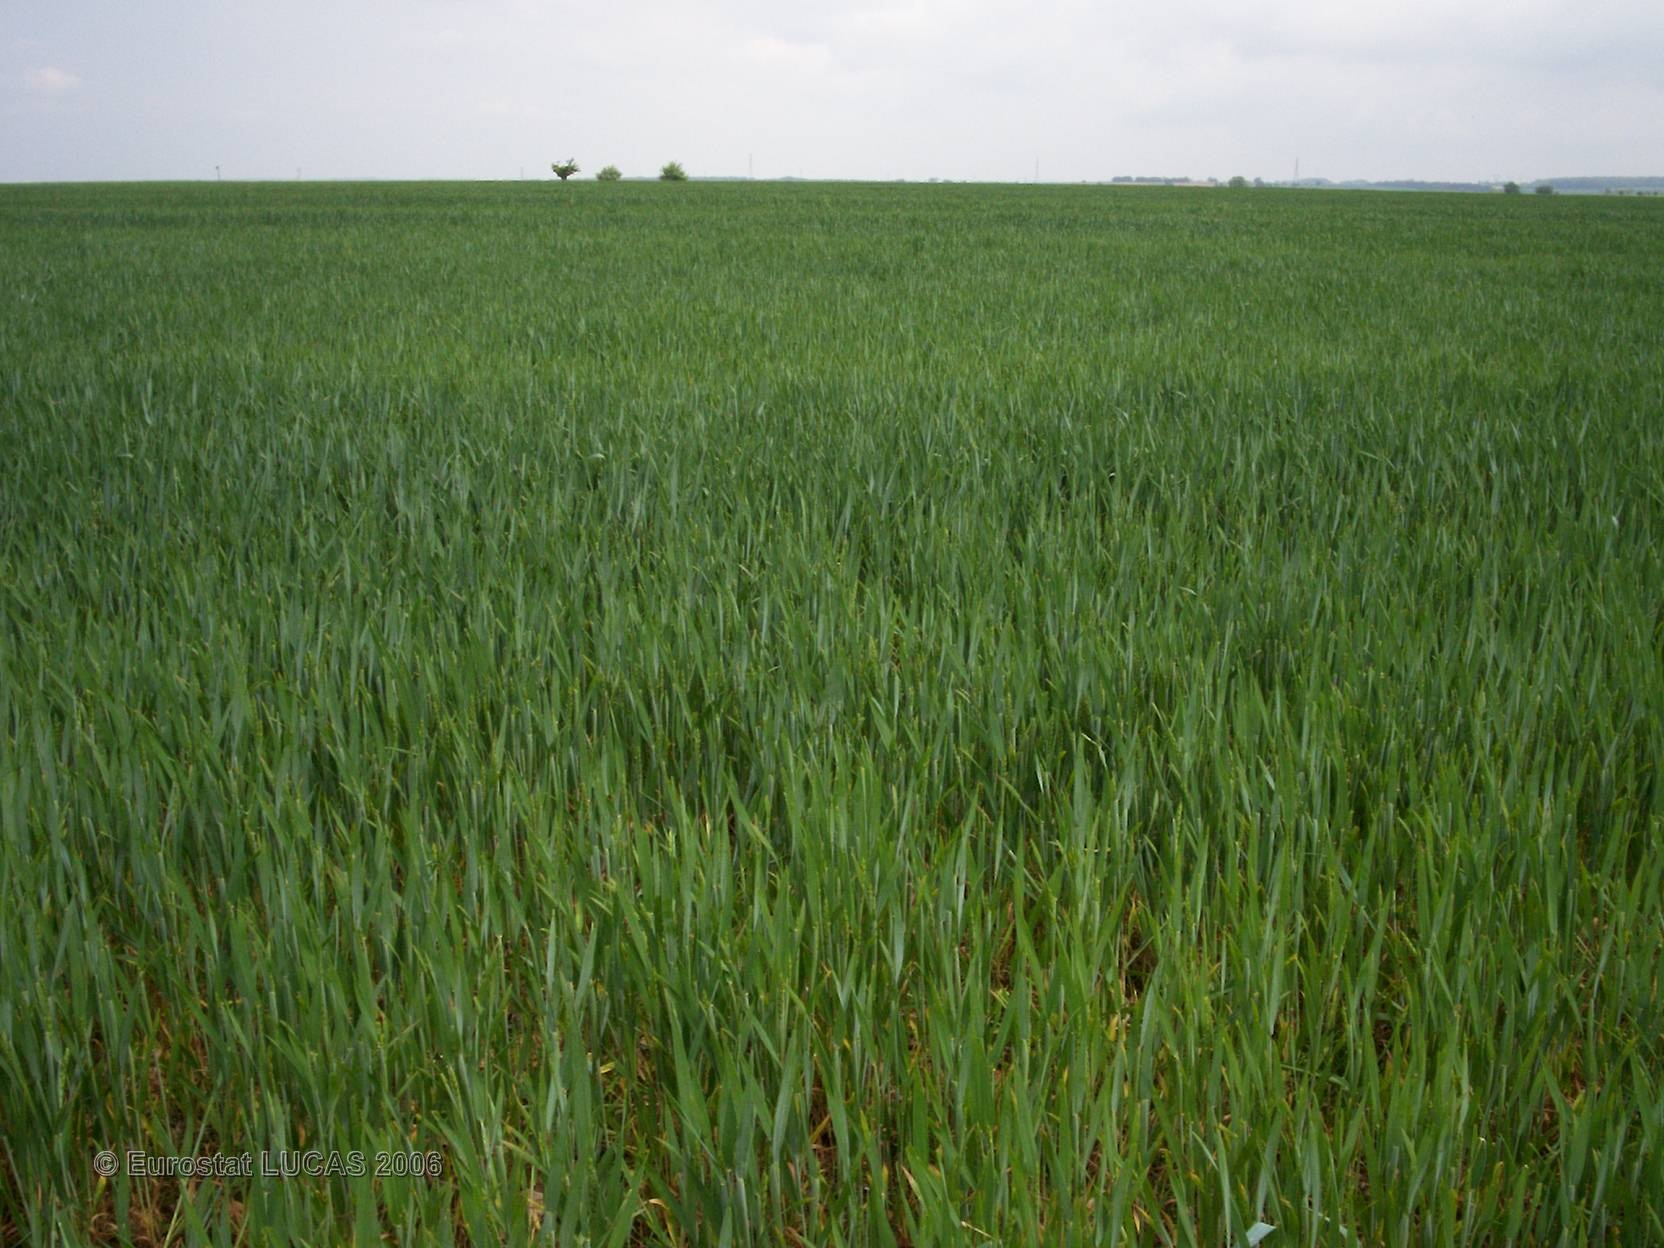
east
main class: Cropland
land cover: Common wheat
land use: Agriculture (excluding fallow land and kitchen gardens)
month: May
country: FR
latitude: 46.6240
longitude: 0.3820
